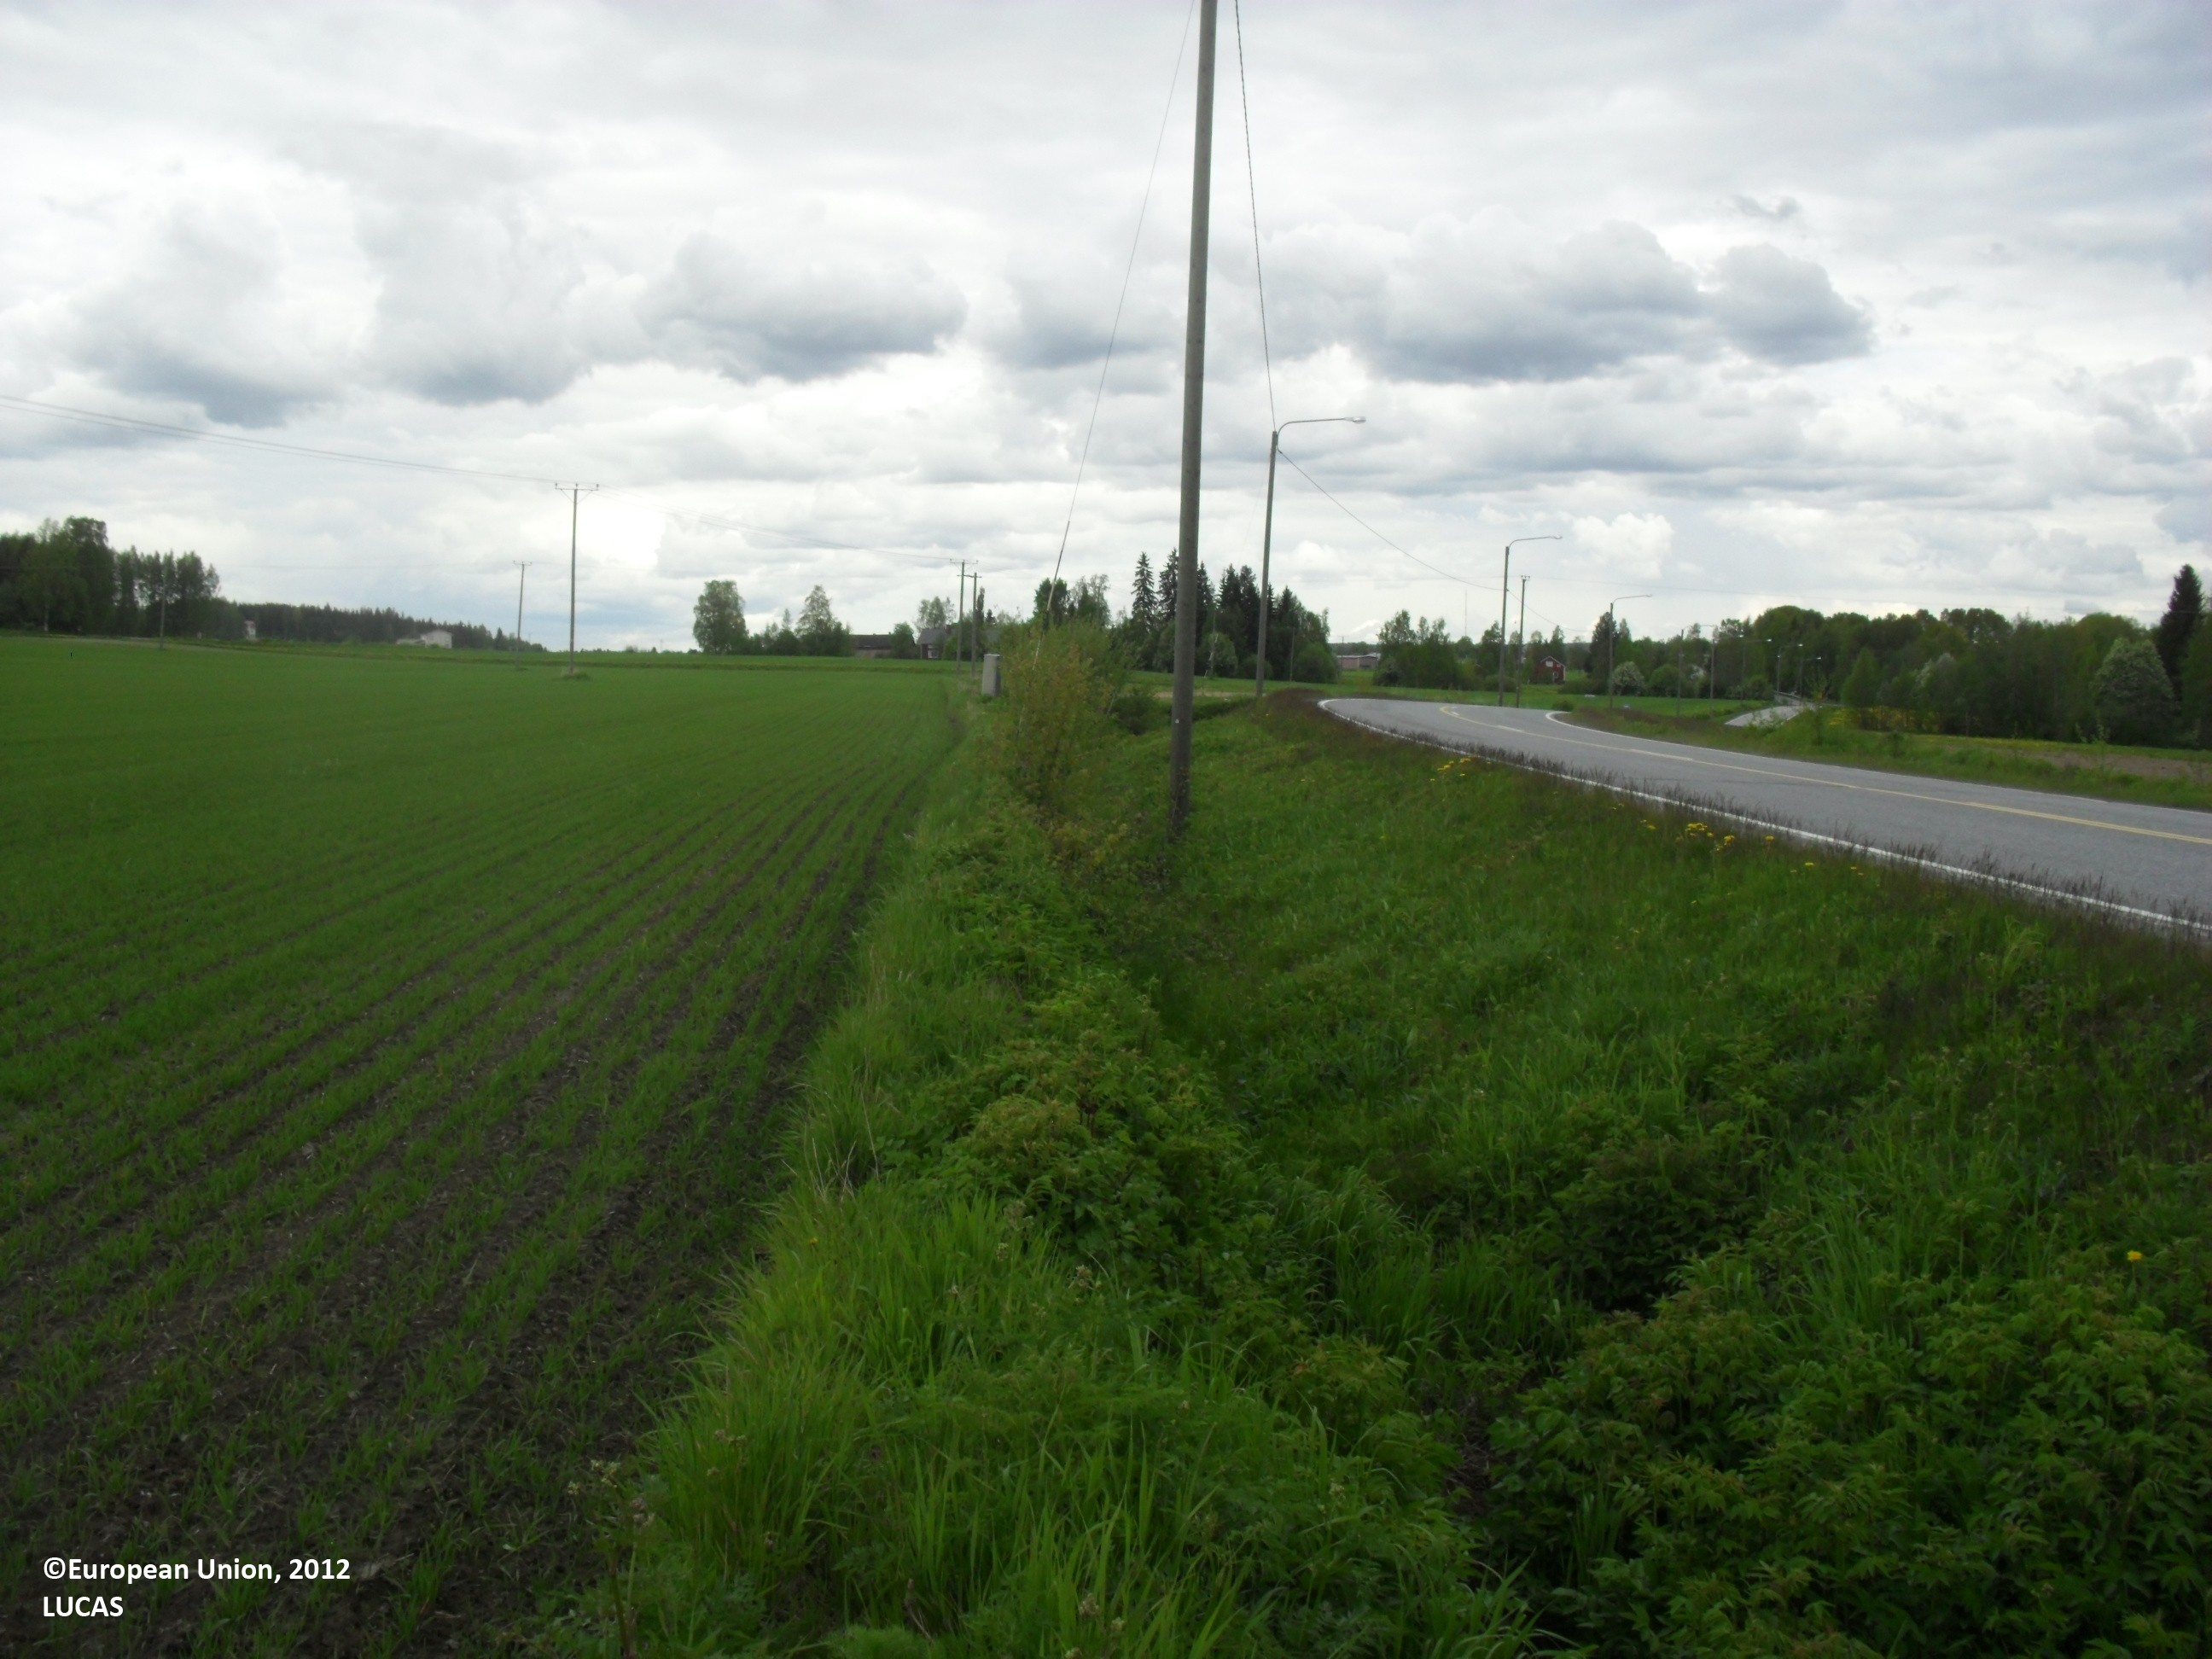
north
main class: Cropland
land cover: Oats
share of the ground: < 10 %
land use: Agriculture (excluding fallow land and kitchen gardens)
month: June
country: FI
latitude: 62.9256
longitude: 22.9980
